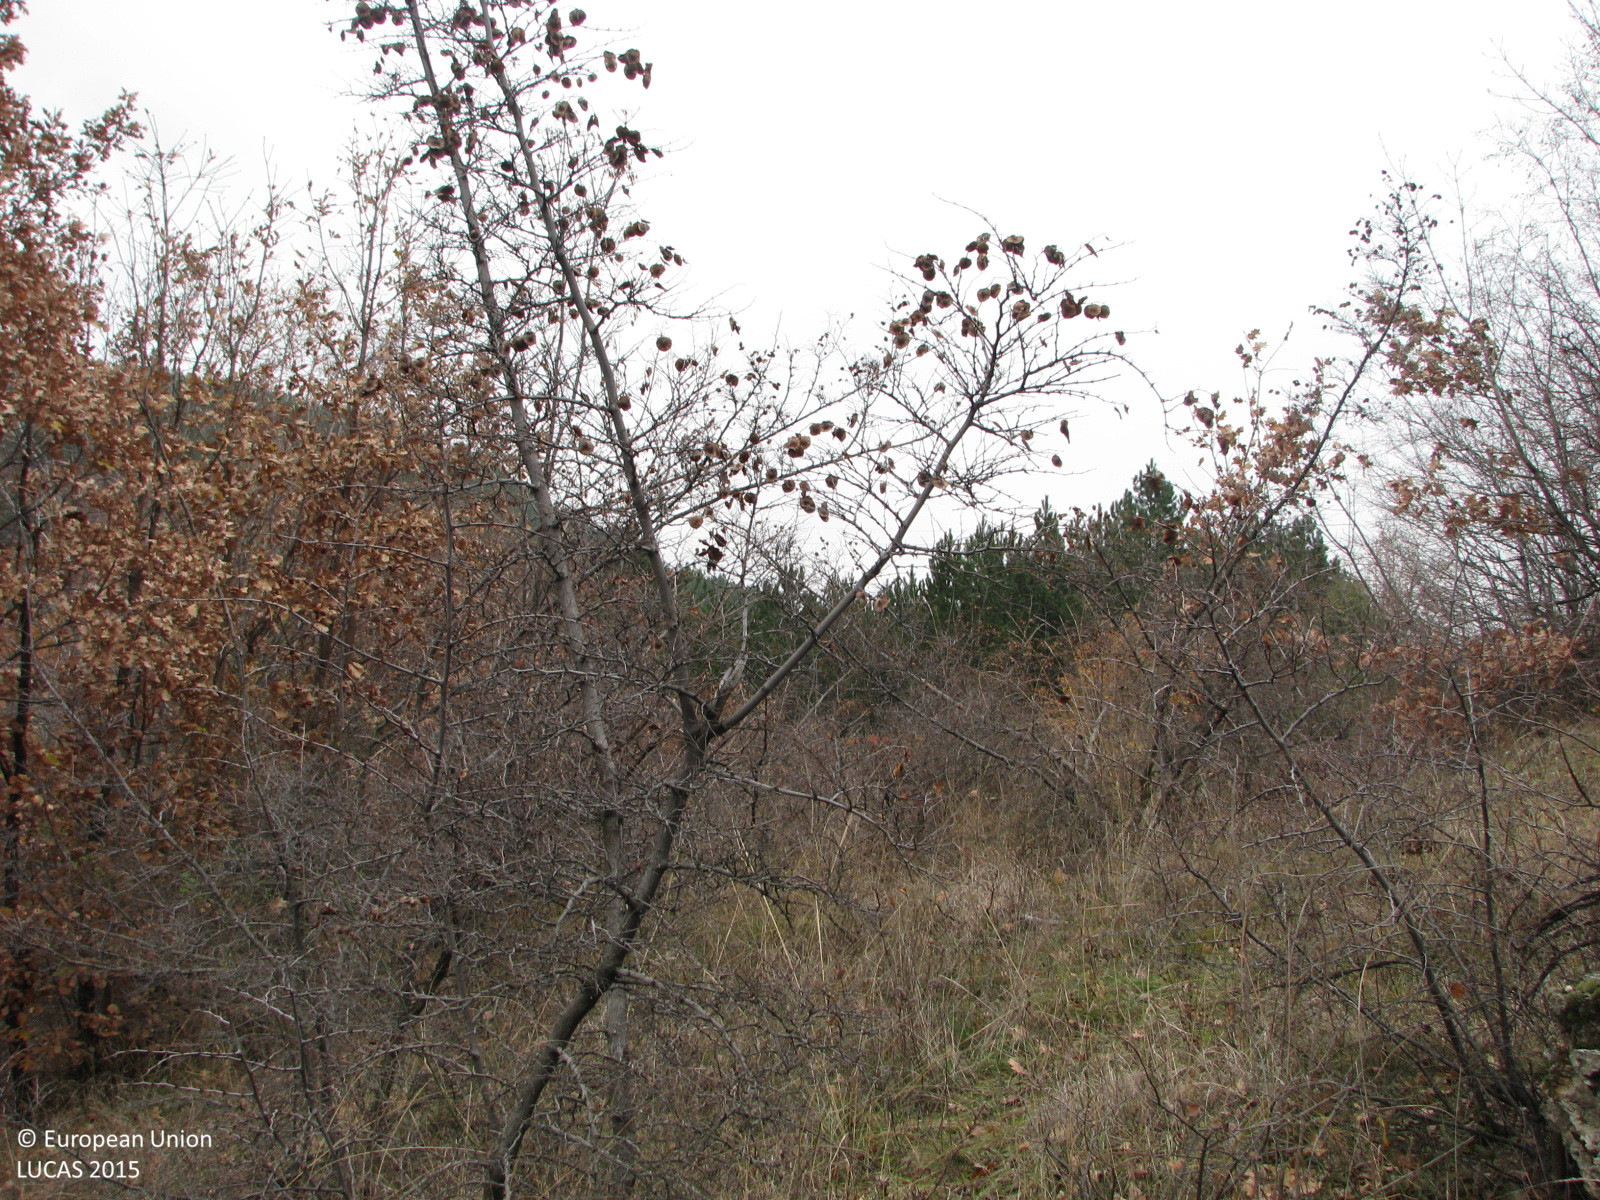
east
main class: Woodland
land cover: Other mixed woodland
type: hemiboreal forest and nemoral coniferous forest and mixed broadleaved-coniferous forest
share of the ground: > 75 %
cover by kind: coniferous forest trees 50 %, broadleaved forest trees 35 %, shrubs 5 %, herbaceous plants 5 %, unconsolidated bare surface 5 %
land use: Forestry
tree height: > 5 m
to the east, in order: Other mixed woodland; Grassland with sparse tree/shrub cover; Pine dominated mixed woodland; Pine dominated coniferous woodland
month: December
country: BG
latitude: 42.2241
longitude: 24.0088
